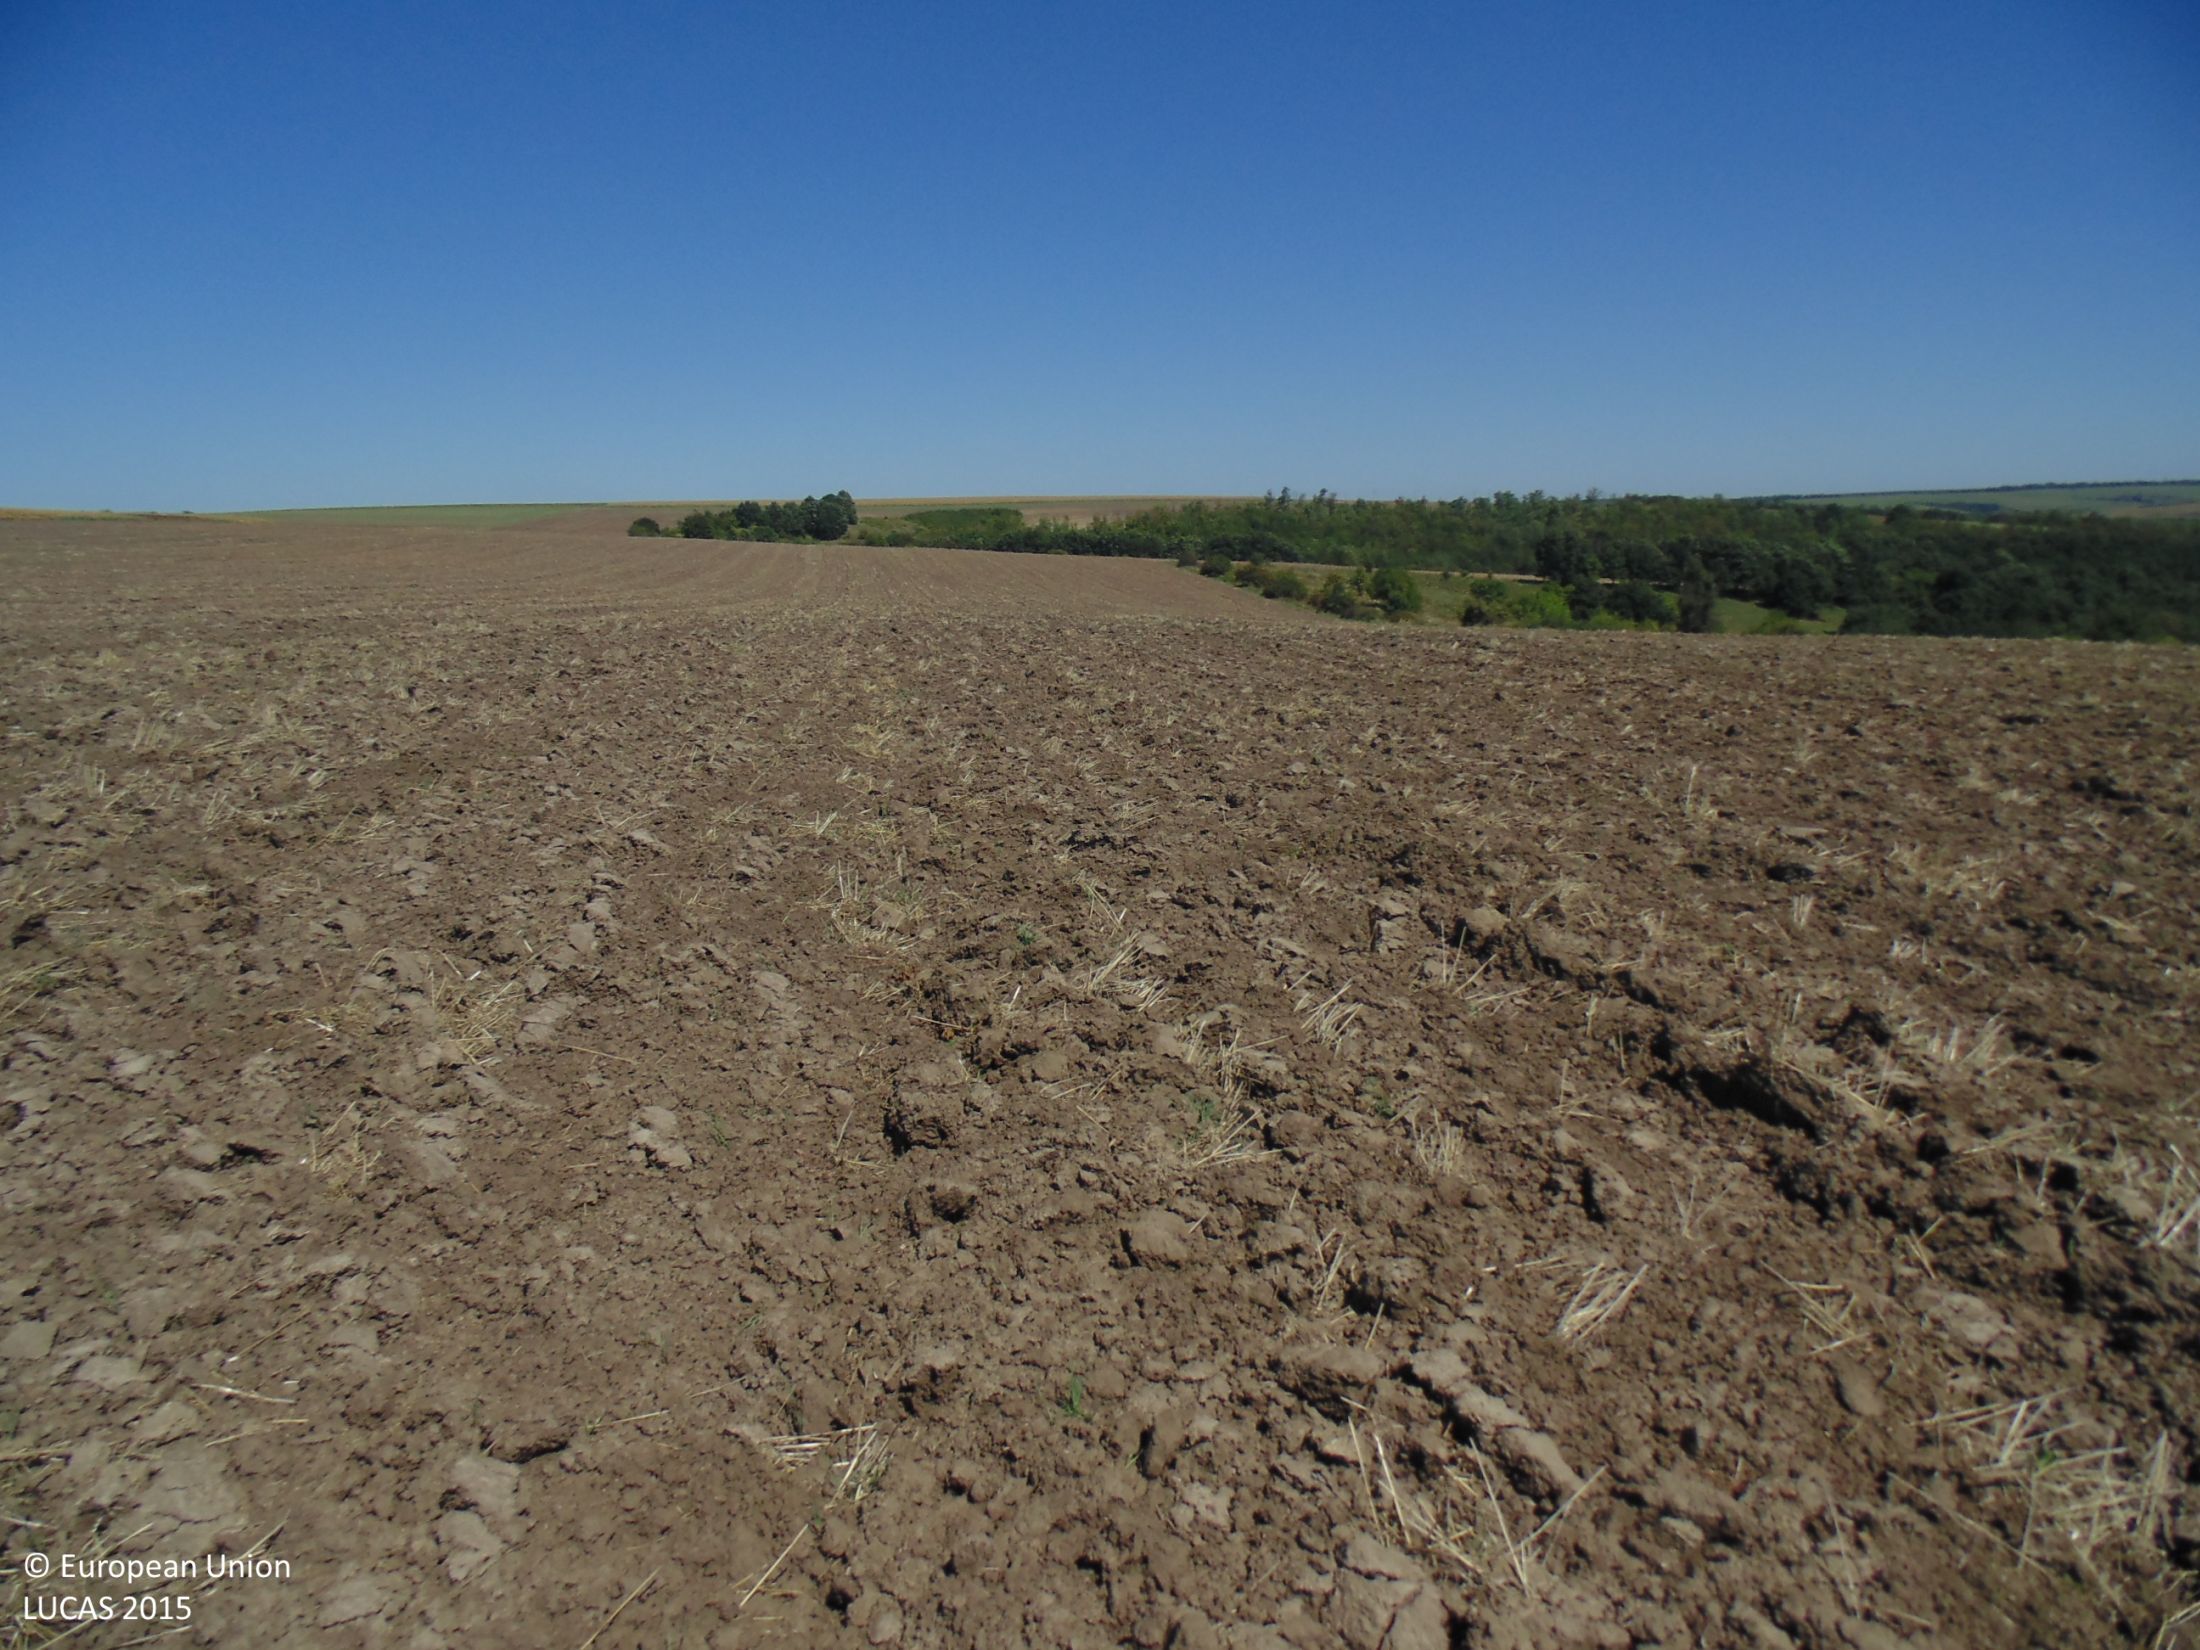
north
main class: Cropland
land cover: Common wheat
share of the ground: < 10 %
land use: Agriculture (excluding fallow land and kitchen gardens)
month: September
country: BG
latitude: 43.7580
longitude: 27.3575
